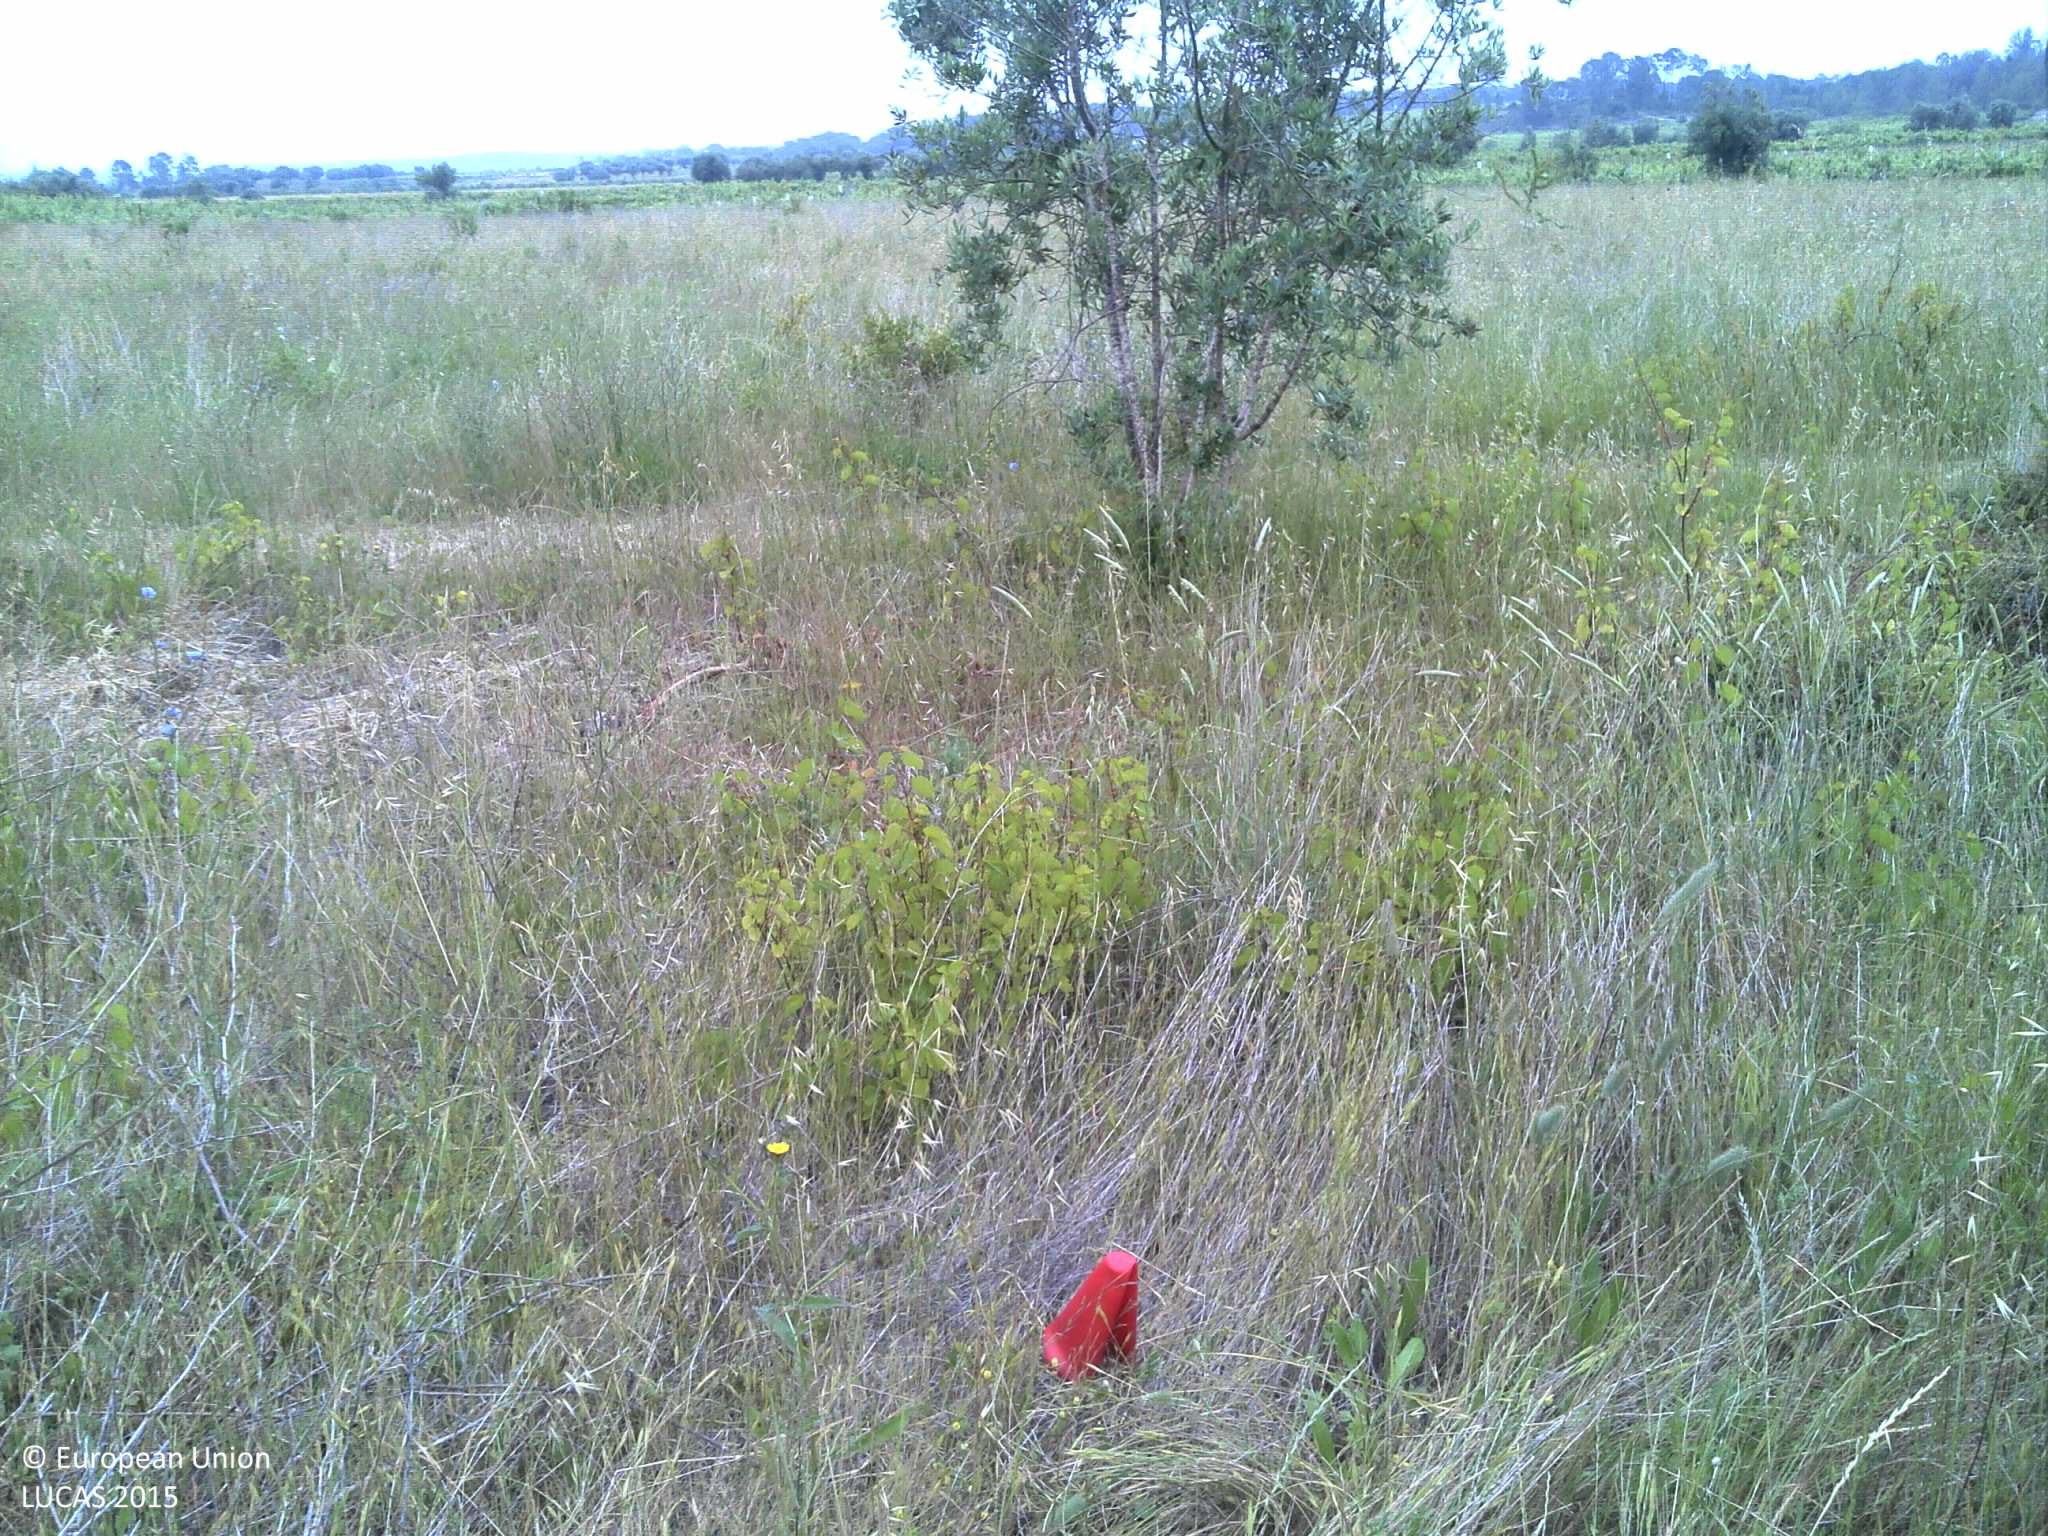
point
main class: Cropland
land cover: Vineyards
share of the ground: 10 - 25 %
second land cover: Grassland without tree/shrub cover
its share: 50 - 75 %
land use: Abandoned areas
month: June
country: PT
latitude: 40.3208
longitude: -8.6024
